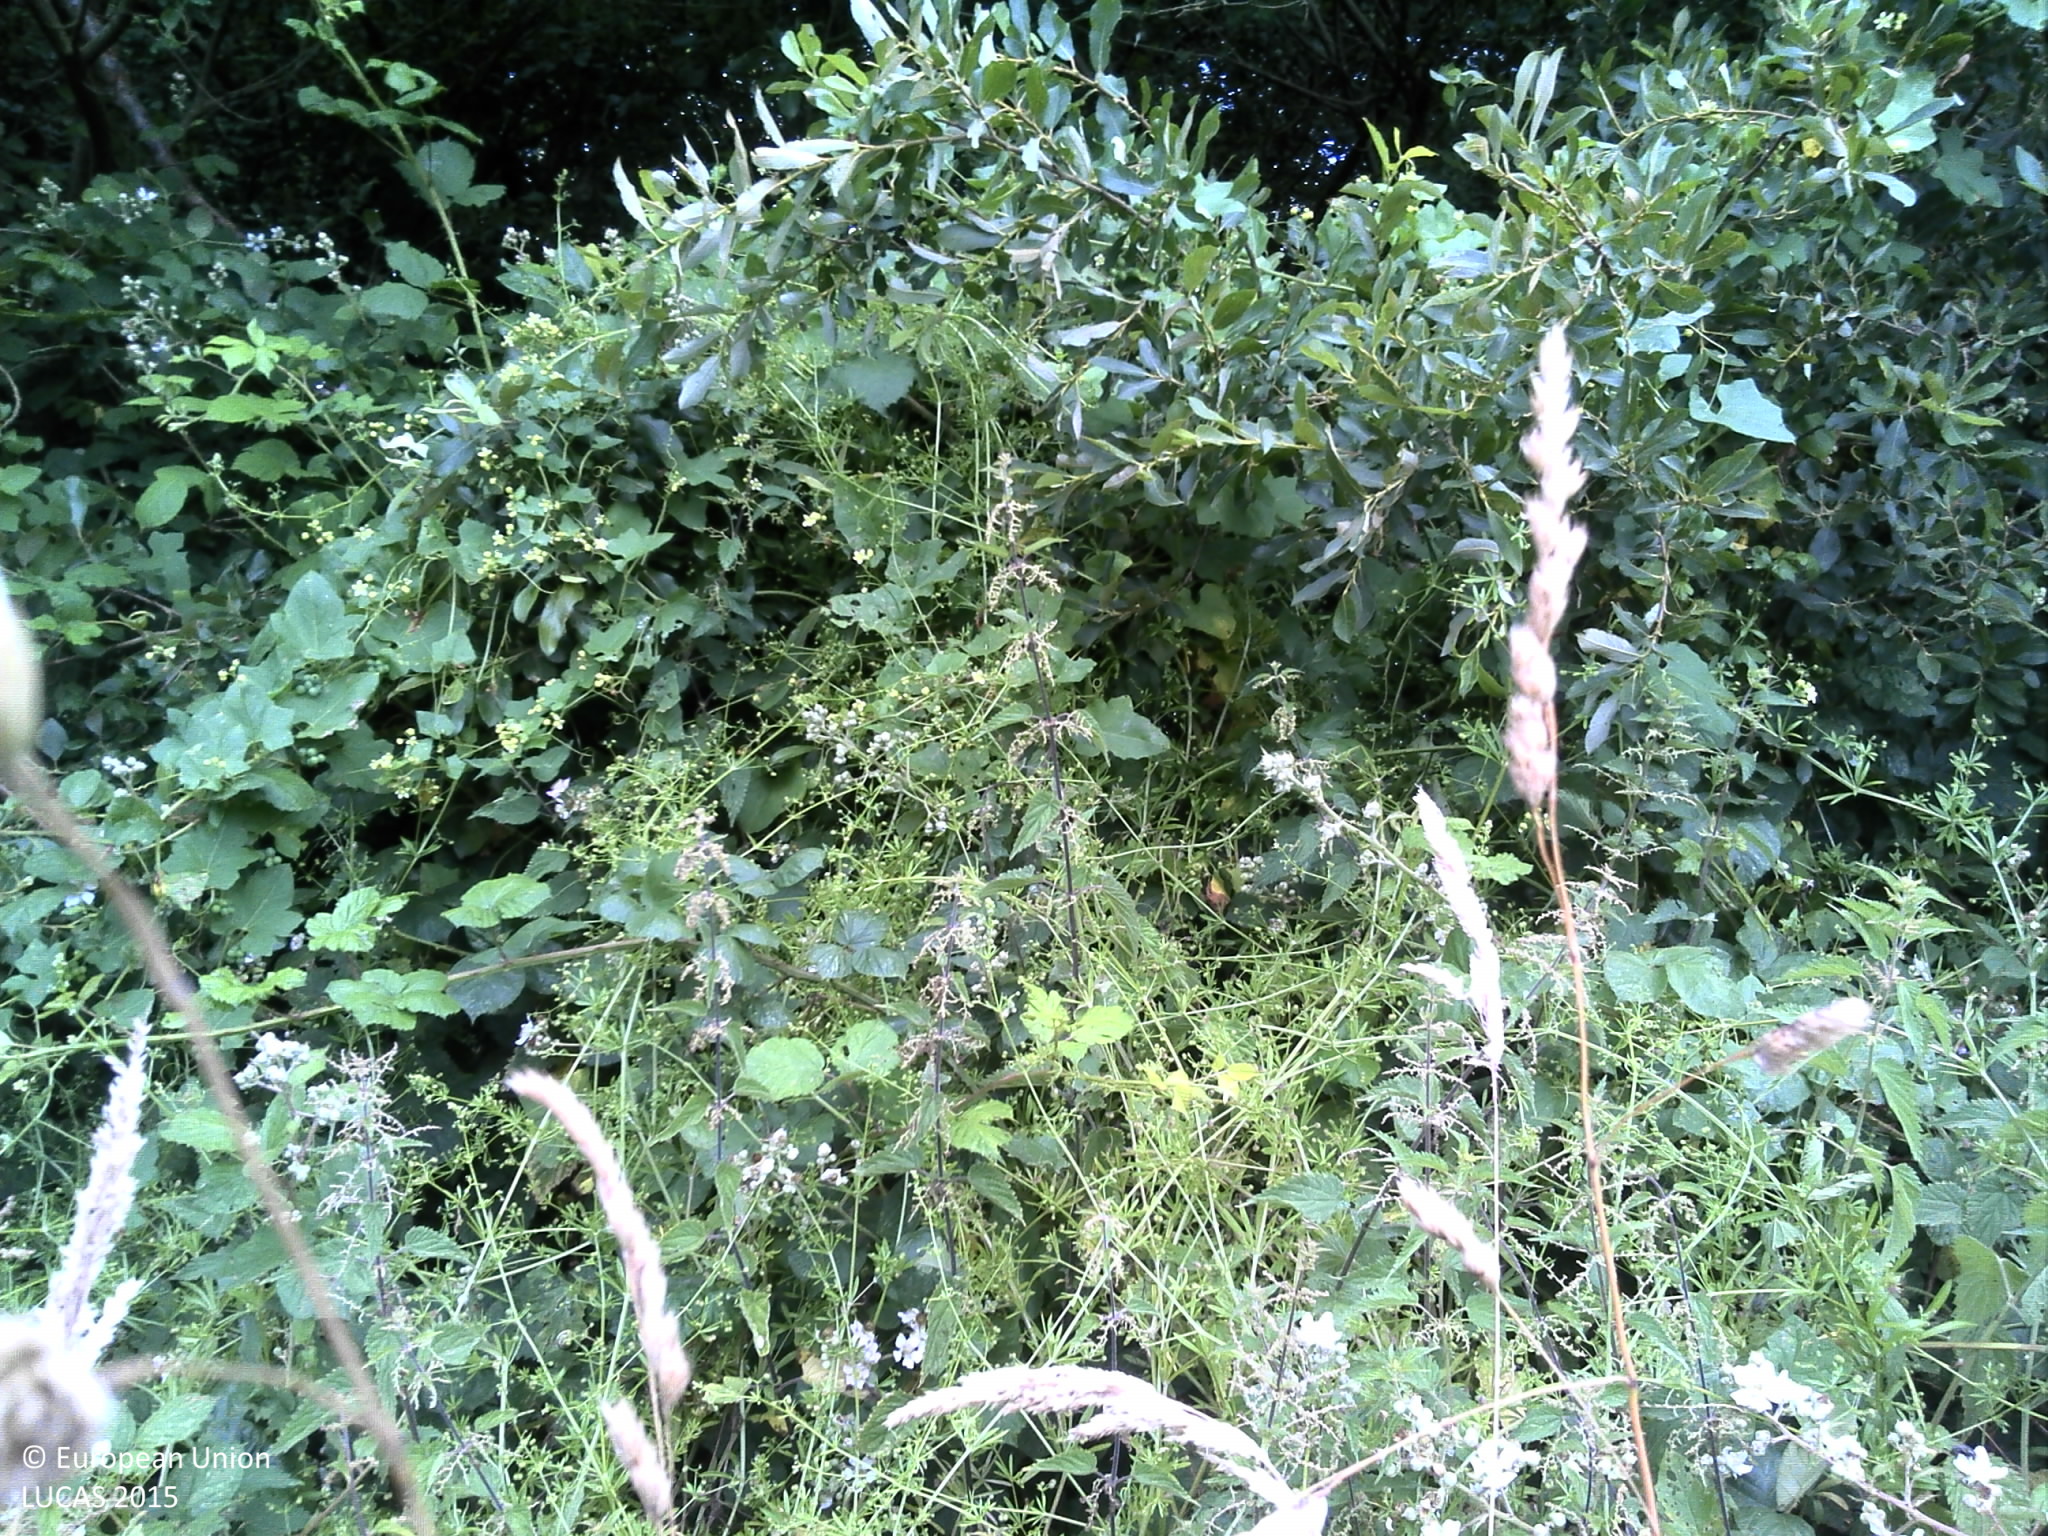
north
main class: Woodland
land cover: Broadleaved woodland
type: acidophilous oak and oak-birch forest
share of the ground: > 75 %
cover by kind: broadleaved forest trees 90 %, shrubs 5 %, herbaceous plants 5 %
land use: Agriculture (excluding fallow land and kitchen gardens)
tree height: > 5 m
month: July
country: FR
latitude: 48.1544
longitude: -4.2197
